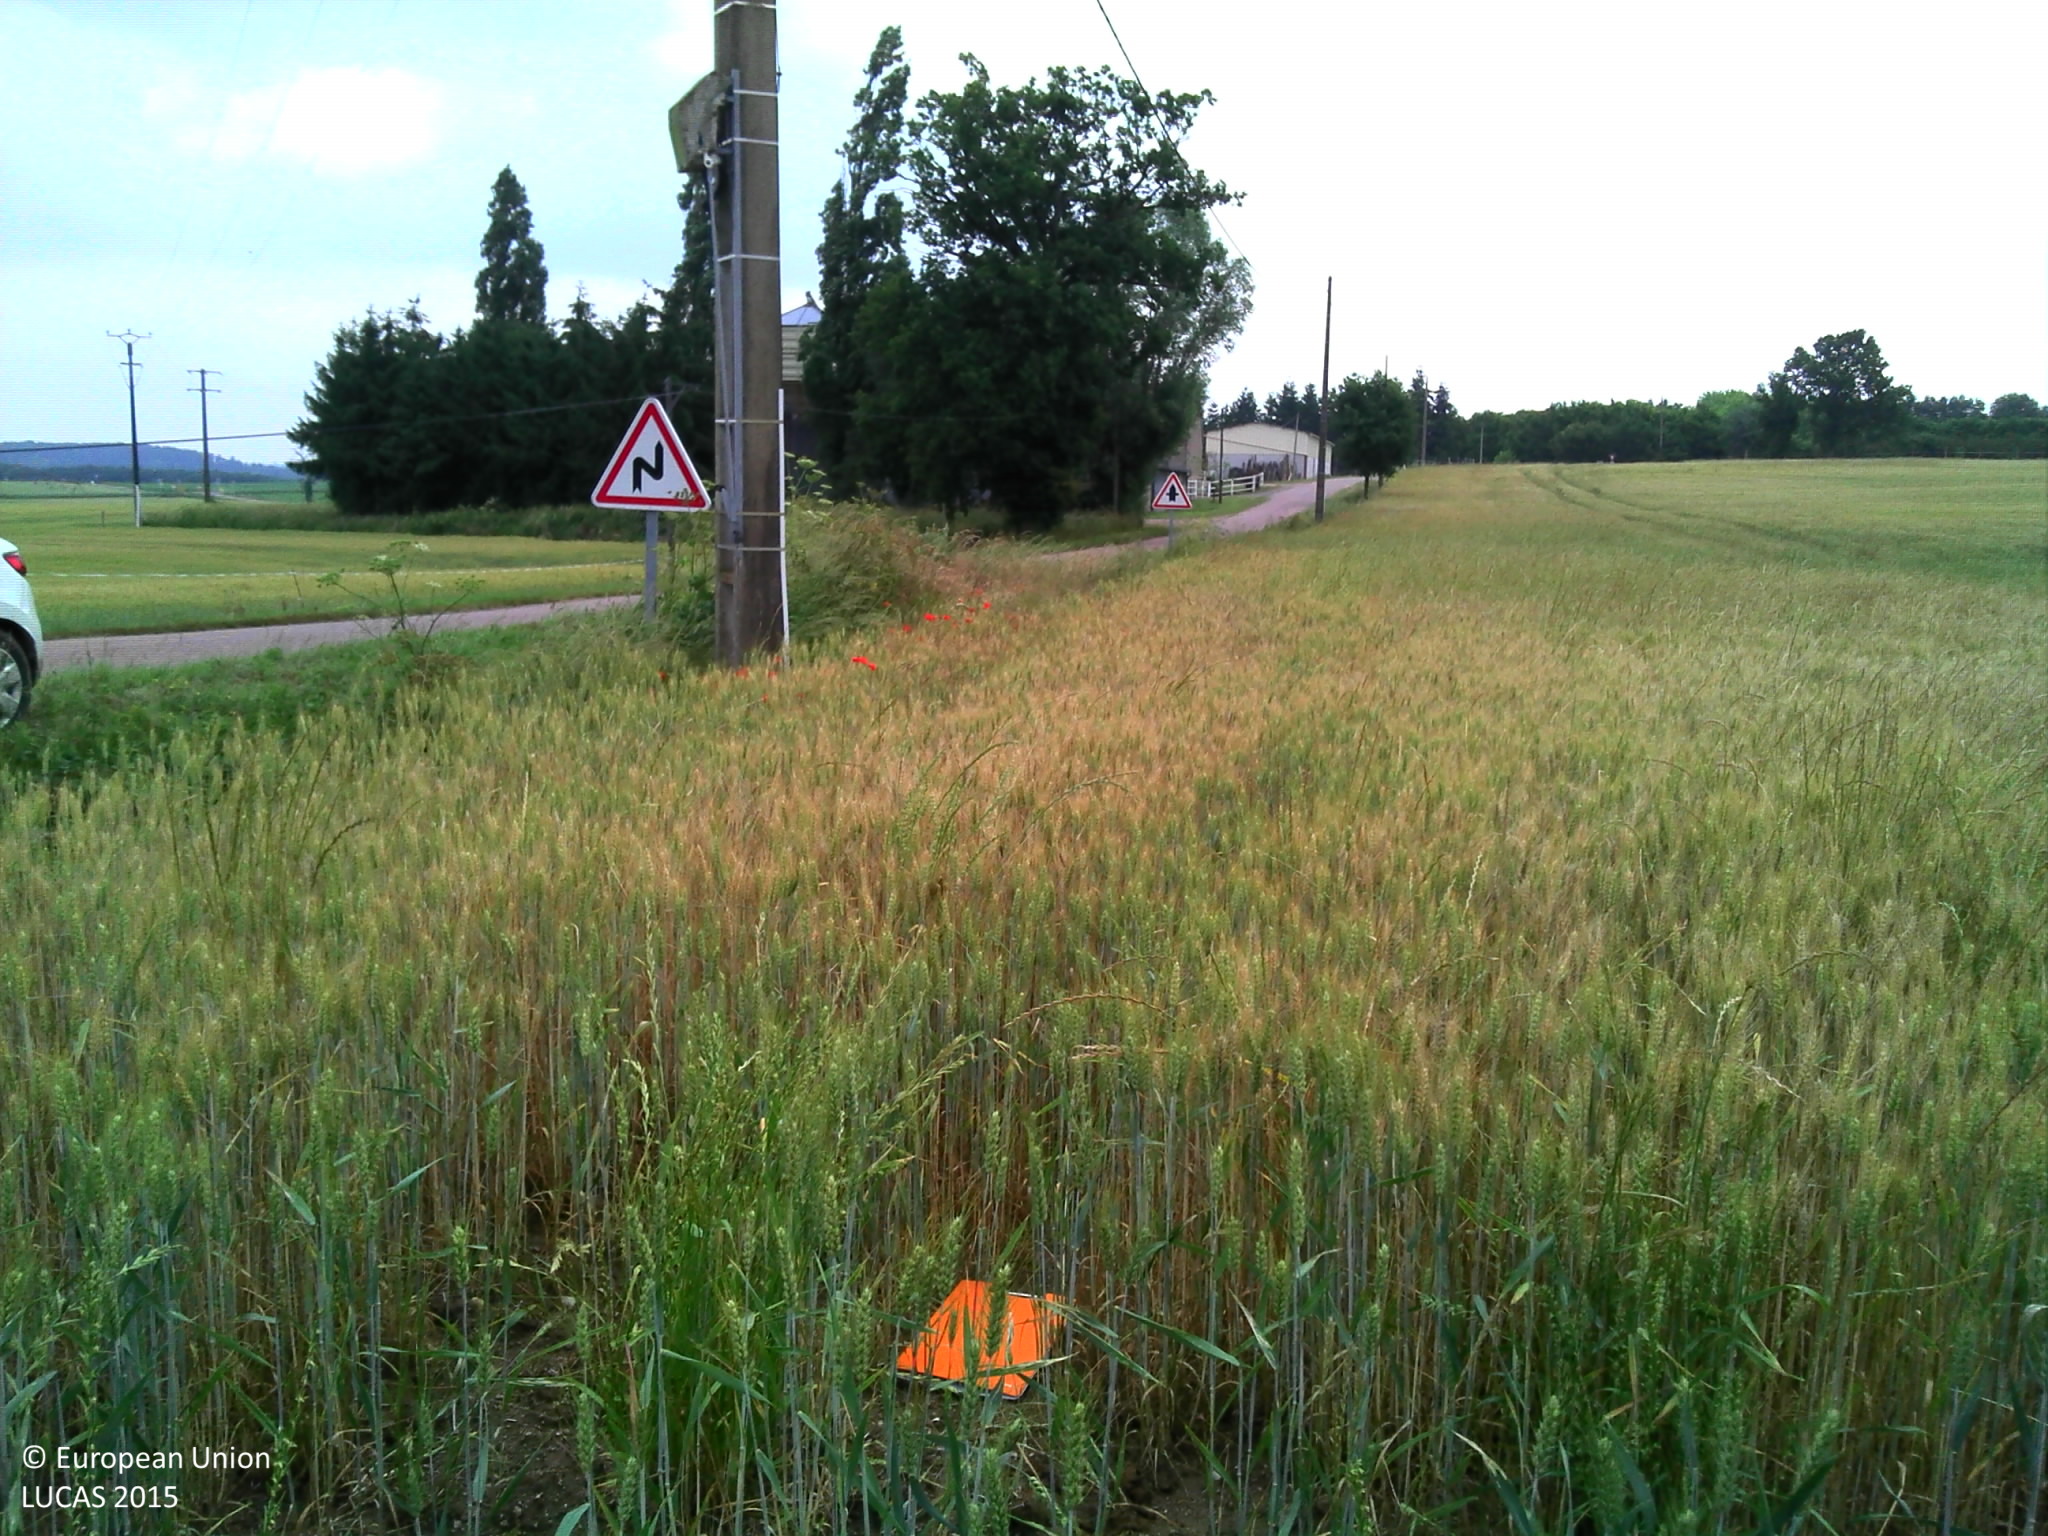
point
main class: Cropland
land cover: Common wheat
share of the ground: > 75 %
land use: Agriculture (excluding fallow land and kitchen gardens)
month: June
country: FR
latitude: 46.6077
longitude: 2.6973
